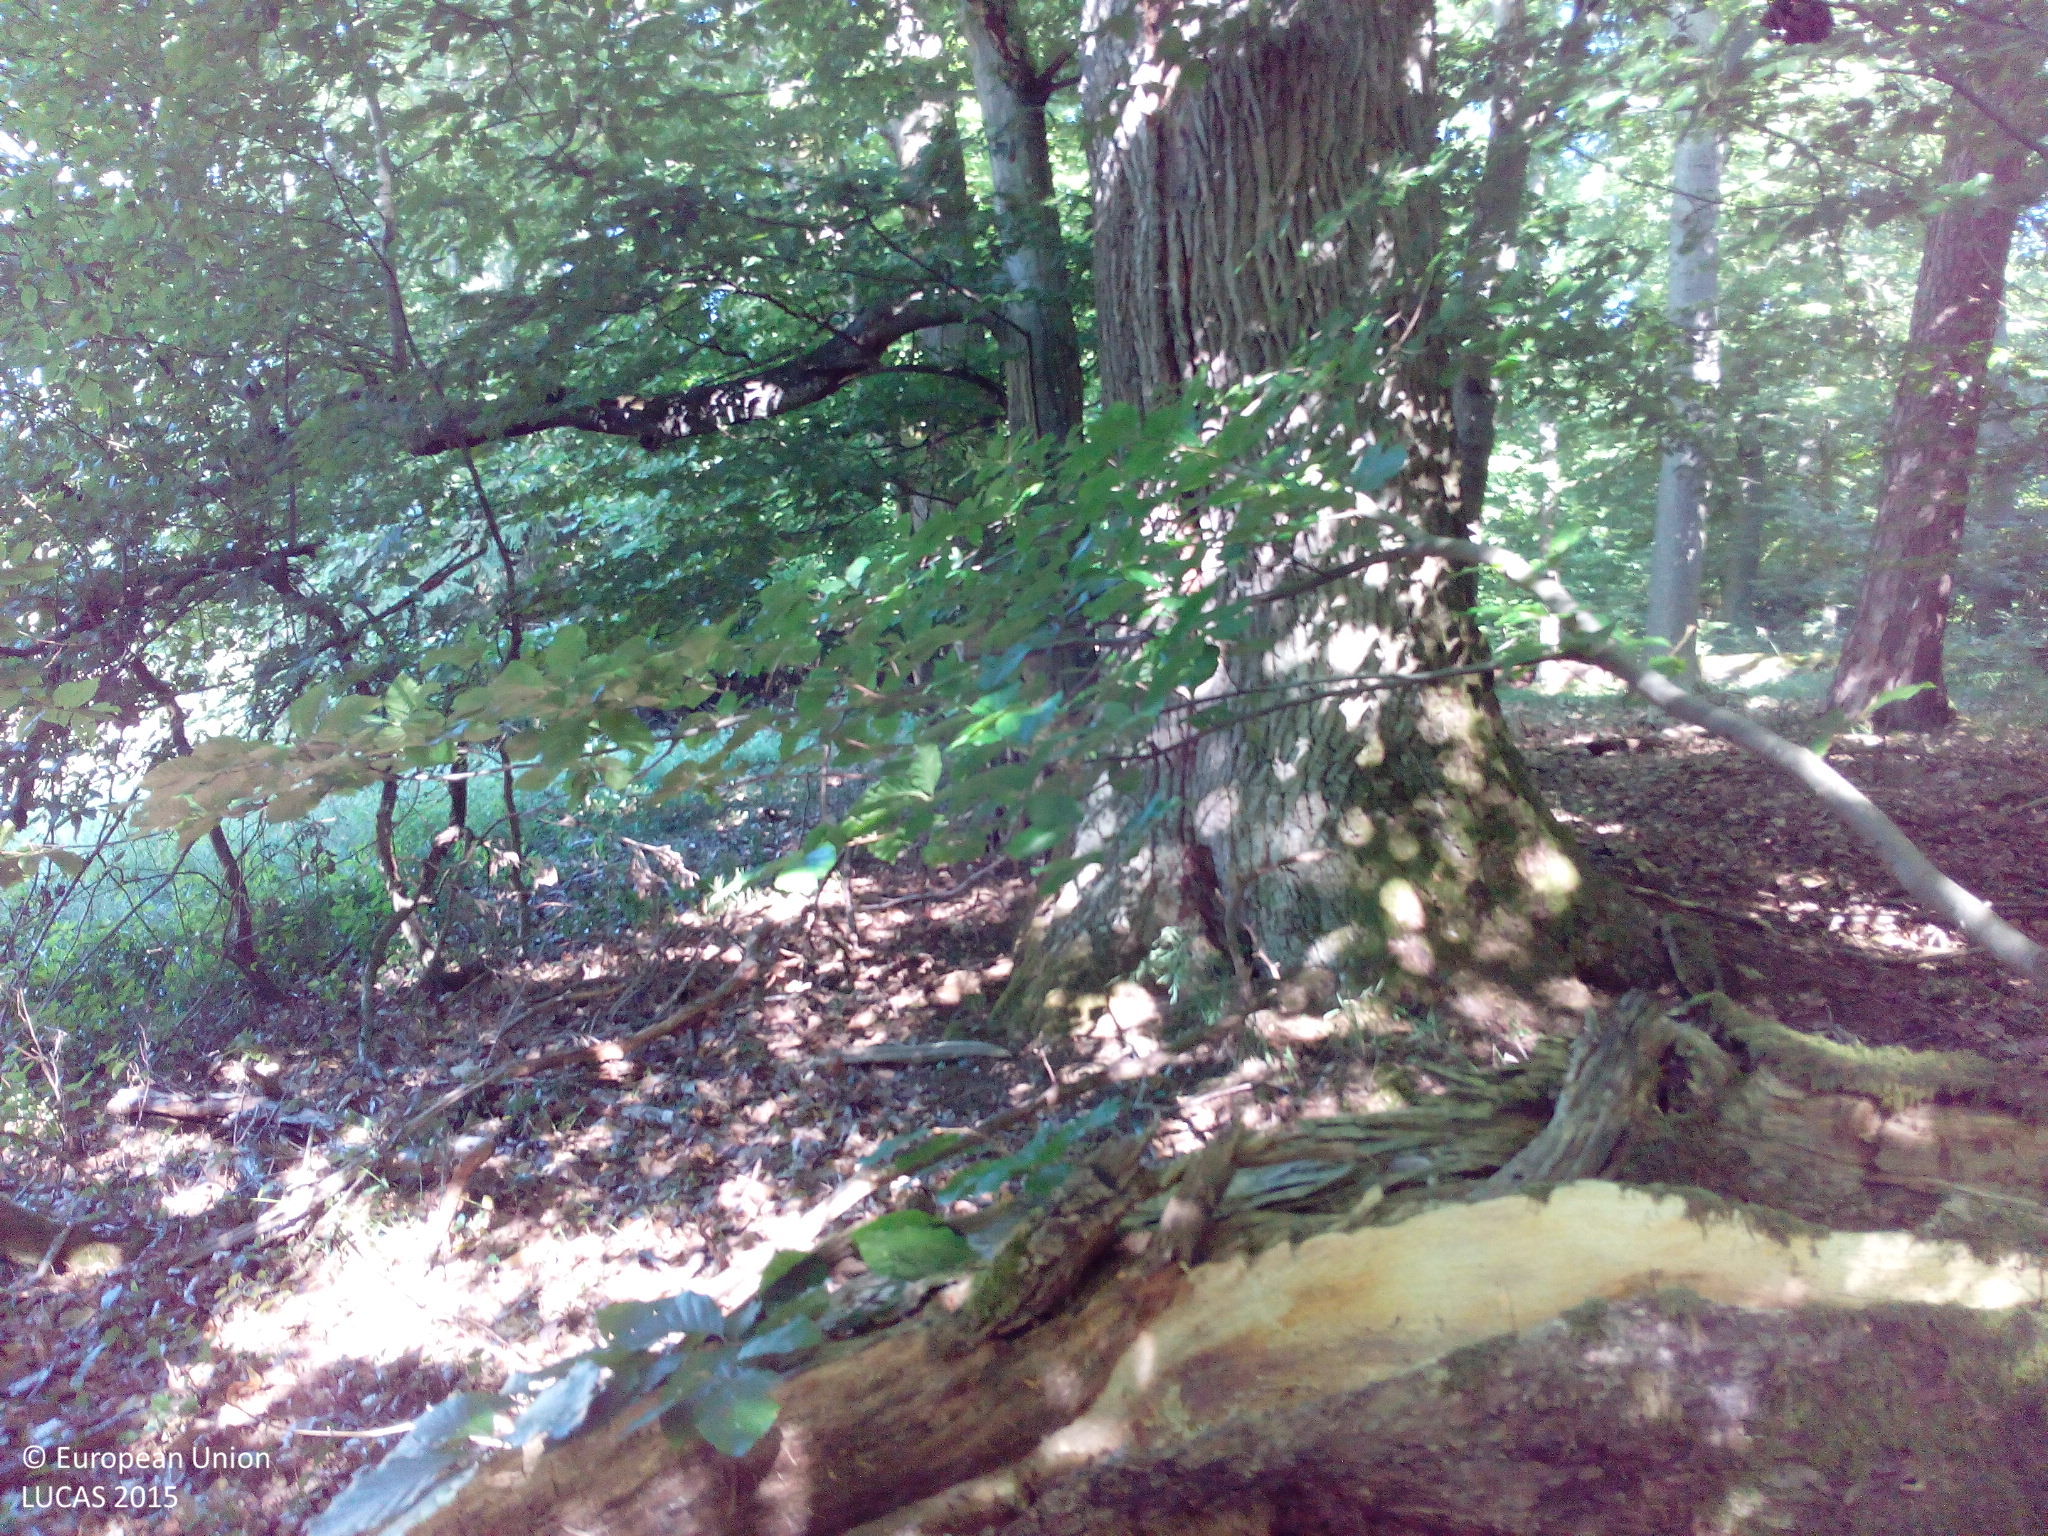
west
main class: Woodland
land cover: Broadleaved woodland
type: mesophytic deciduous forest
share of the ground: > 75 %
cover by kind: broadleaved forest trees 95 %, unconsolidated bare surface 5 %
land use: Forestry
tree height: > 5 m
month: June
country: DE
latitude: 50.2291
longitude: 8.5565
